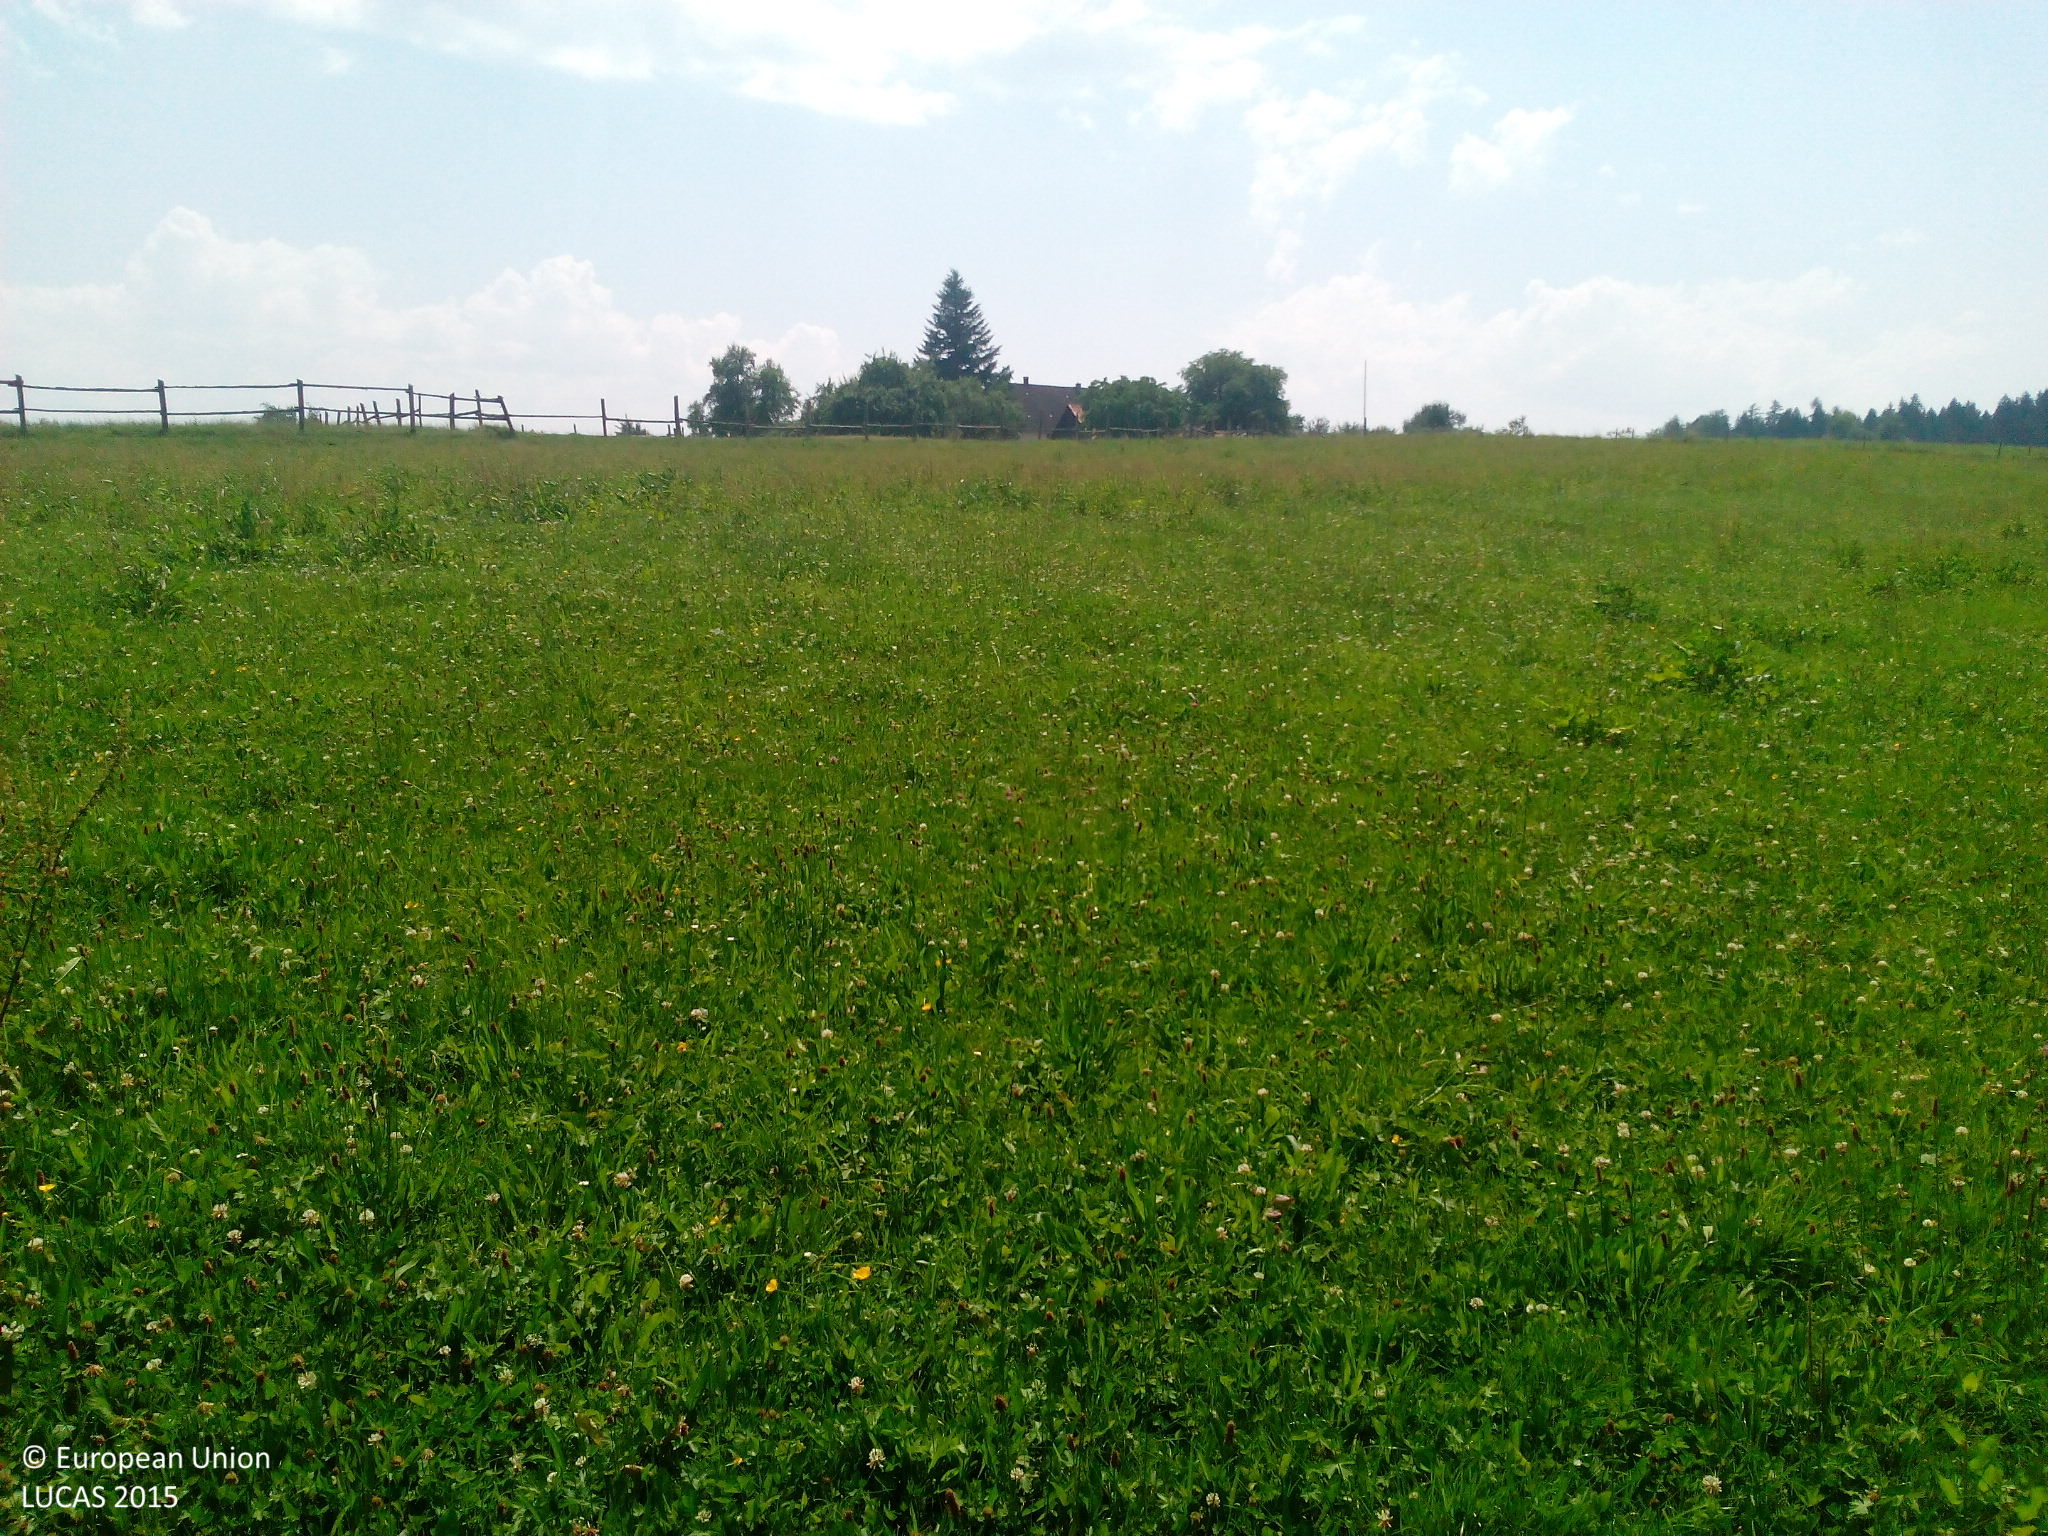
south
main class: Grassland
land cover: Grassland without tree/shrub cover
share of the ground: > 75 %
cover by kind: herbaceous plants 100 %
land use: Agriculture (excluding fallow land and kitchen gardens)
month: July
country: DE
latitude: 47.8615
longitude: 9.3188
